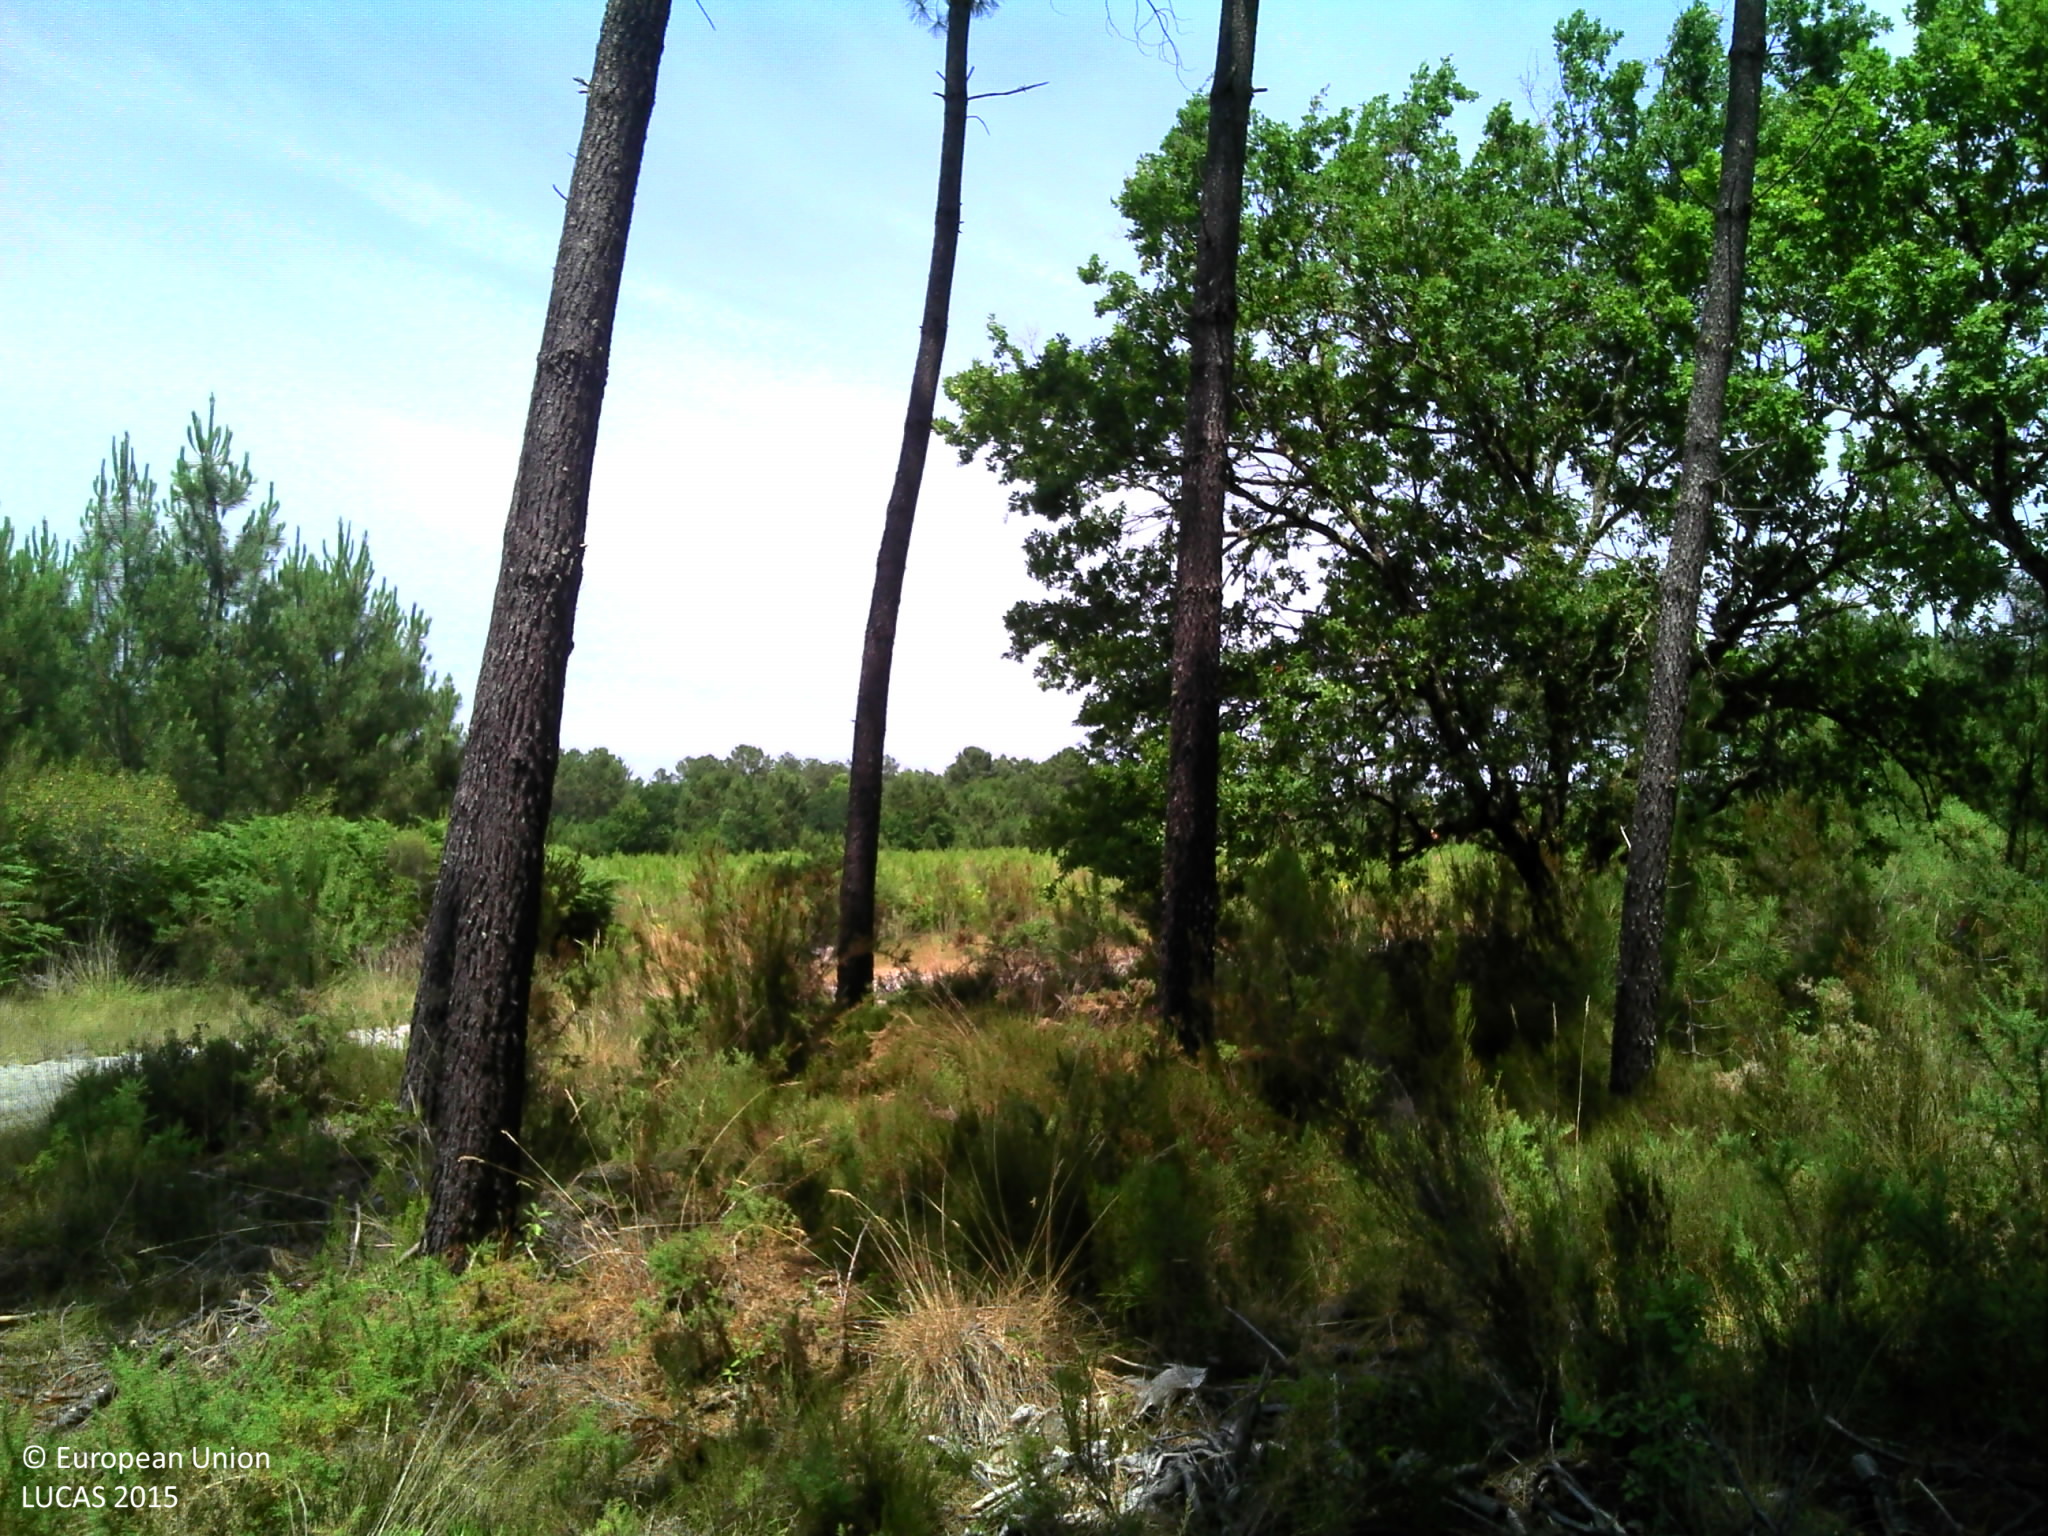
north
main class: Woodland
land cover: Pine dominated coniferous woodland
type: coniferous forest of the mediterranean region
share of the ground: > 75 %
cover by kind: coniferous forest trees 80 %, herbaceous plants 20 %
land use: Forestry
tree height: > 5 m
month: July
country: FR
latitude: 44.3498
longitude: -0.6162
